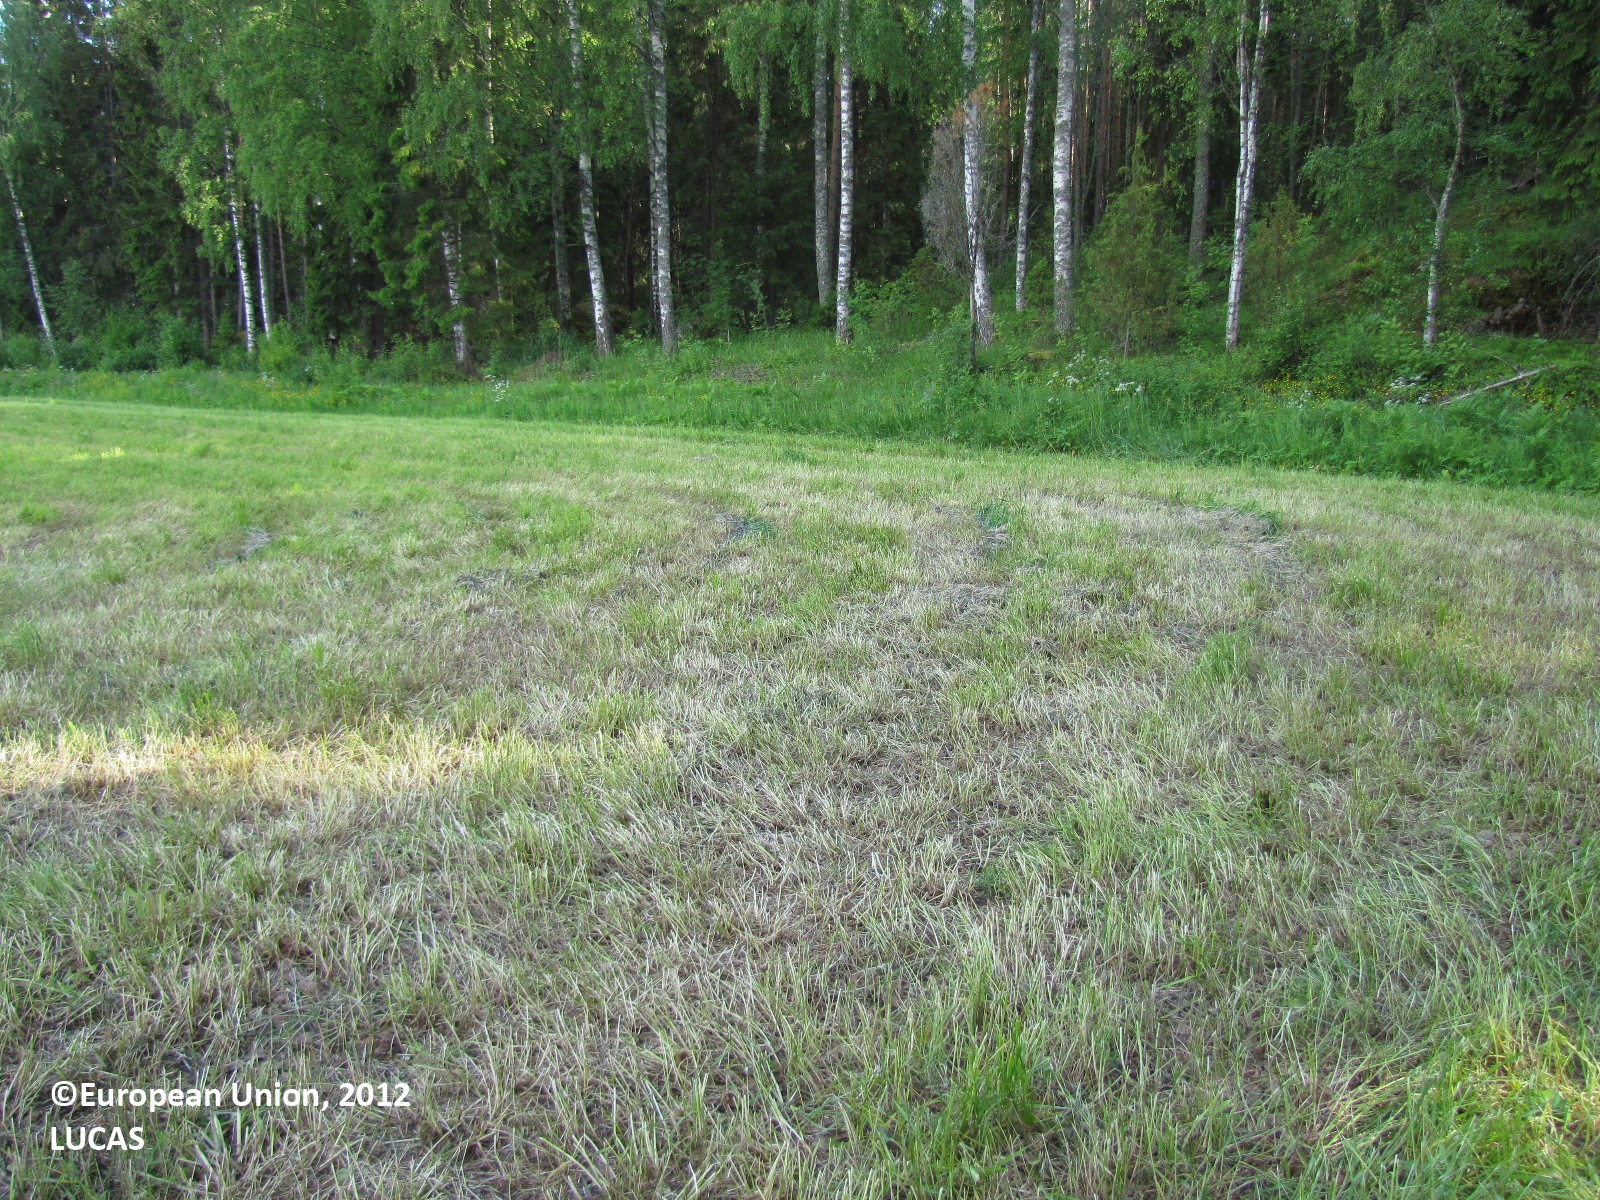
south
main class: Cropland
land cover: Temporary grasslands
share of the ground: 50 - 75 %
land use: Agriculture (excluding fallow land and kitchen gardens)
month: June
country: FI
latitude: 61.4018
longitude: 24.3863
